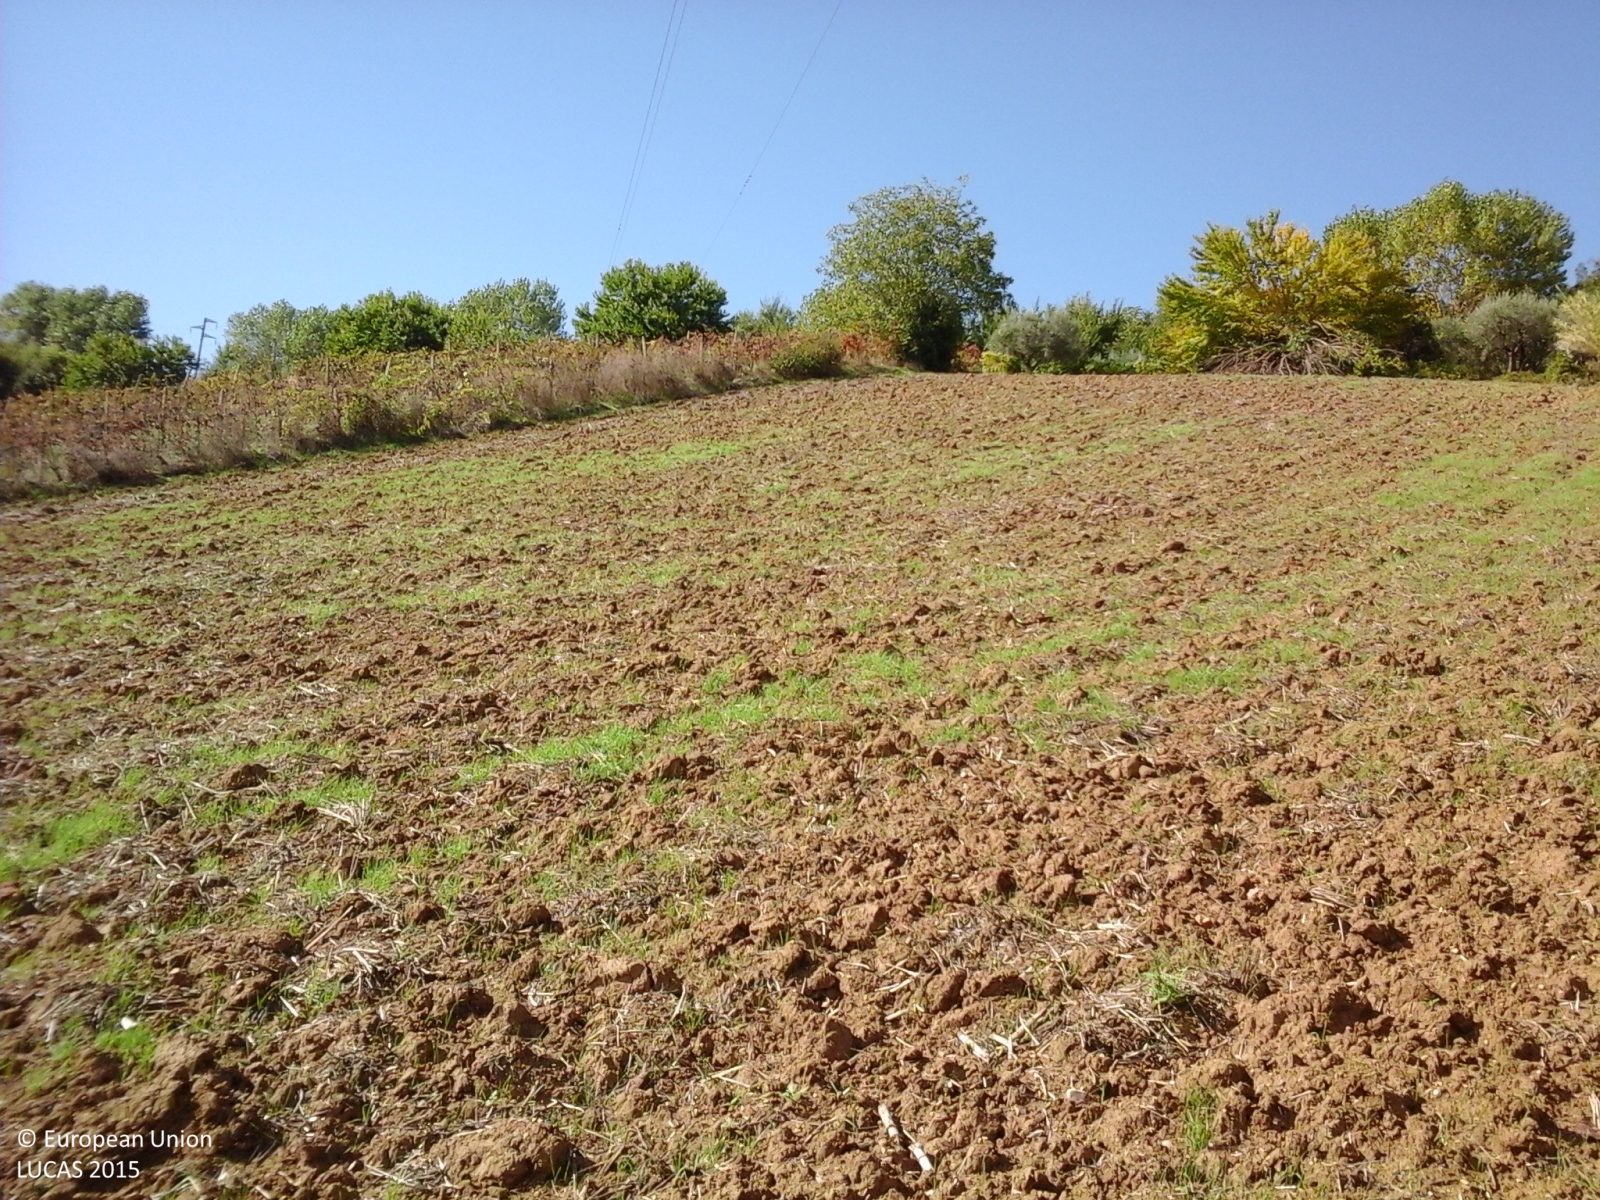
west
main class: Cropland
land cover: Durum wheat
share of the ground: < 10 %
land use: Agriculture (excluding fallow land and kitchen gardens)
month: October
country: IT
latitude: 43.5539
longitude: 13.4206
